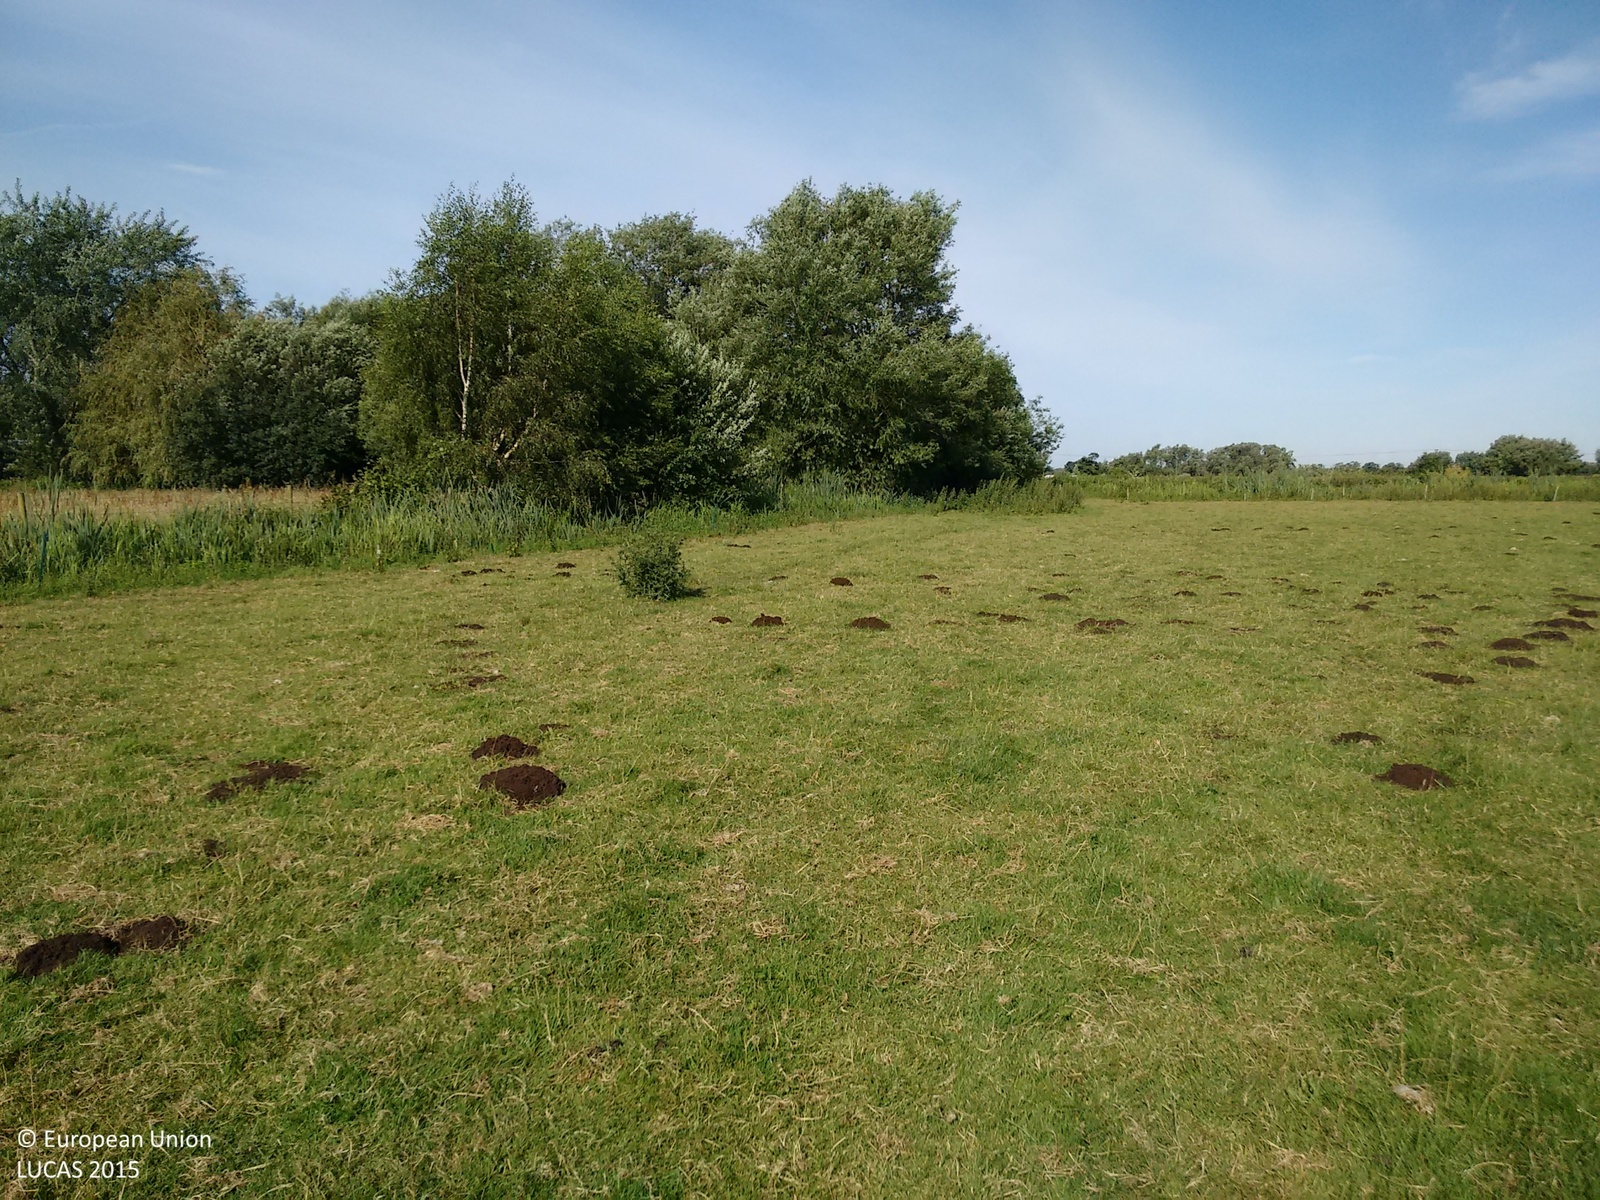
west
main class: Grassland
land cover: Grassland without tree/shrub cover
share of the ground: > 75 %
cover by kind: herbaceous plants 100 %
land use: Agriculture (excluding fallow land and kitchen gardens)
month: July
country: GB
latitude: 51.1610
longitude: -2.7251
